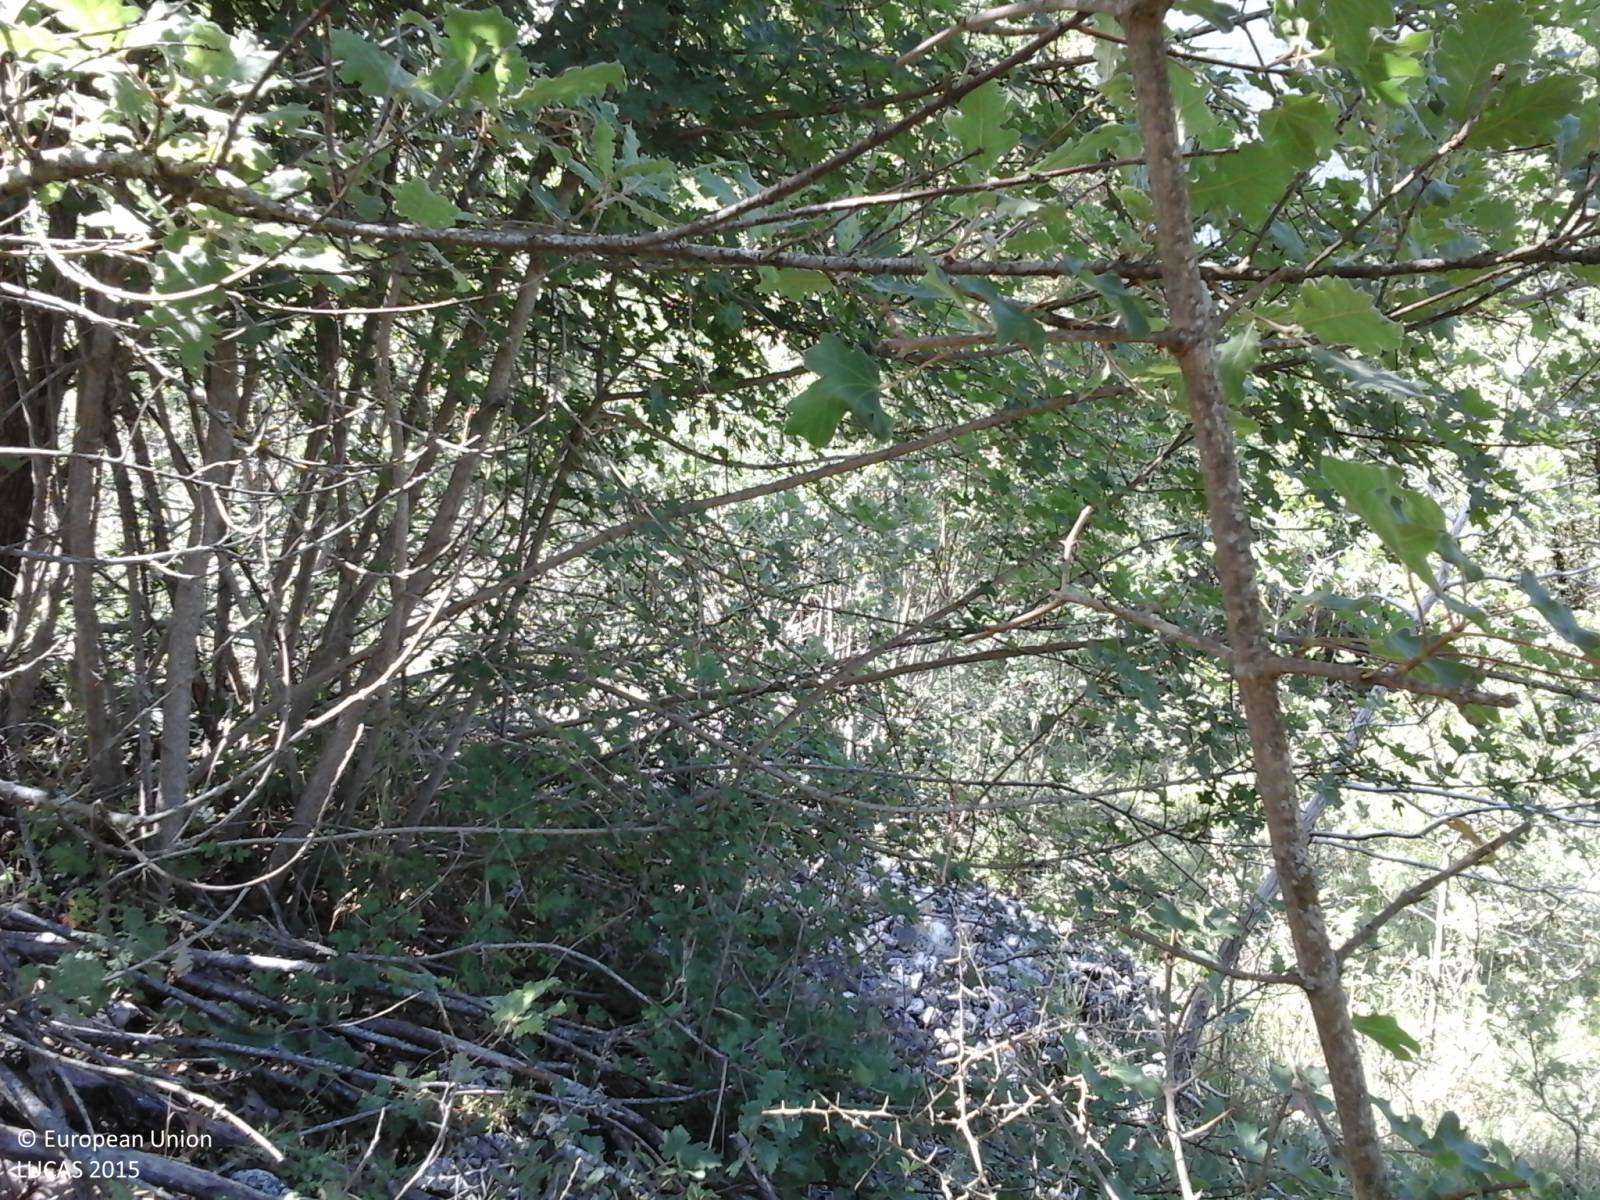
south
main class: Woodland
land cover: Broadleaved woodland
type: thermophilous deciduous forest
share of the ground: 25 - 50 %
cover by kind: herbaceous plants 70 %, broadleaved forest trees 20 %, shrubs 10 %
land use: Semi-natural and natural areas not in use
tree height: < 5 m
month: June
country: IT
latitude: 42.1305
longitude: 13.2914
